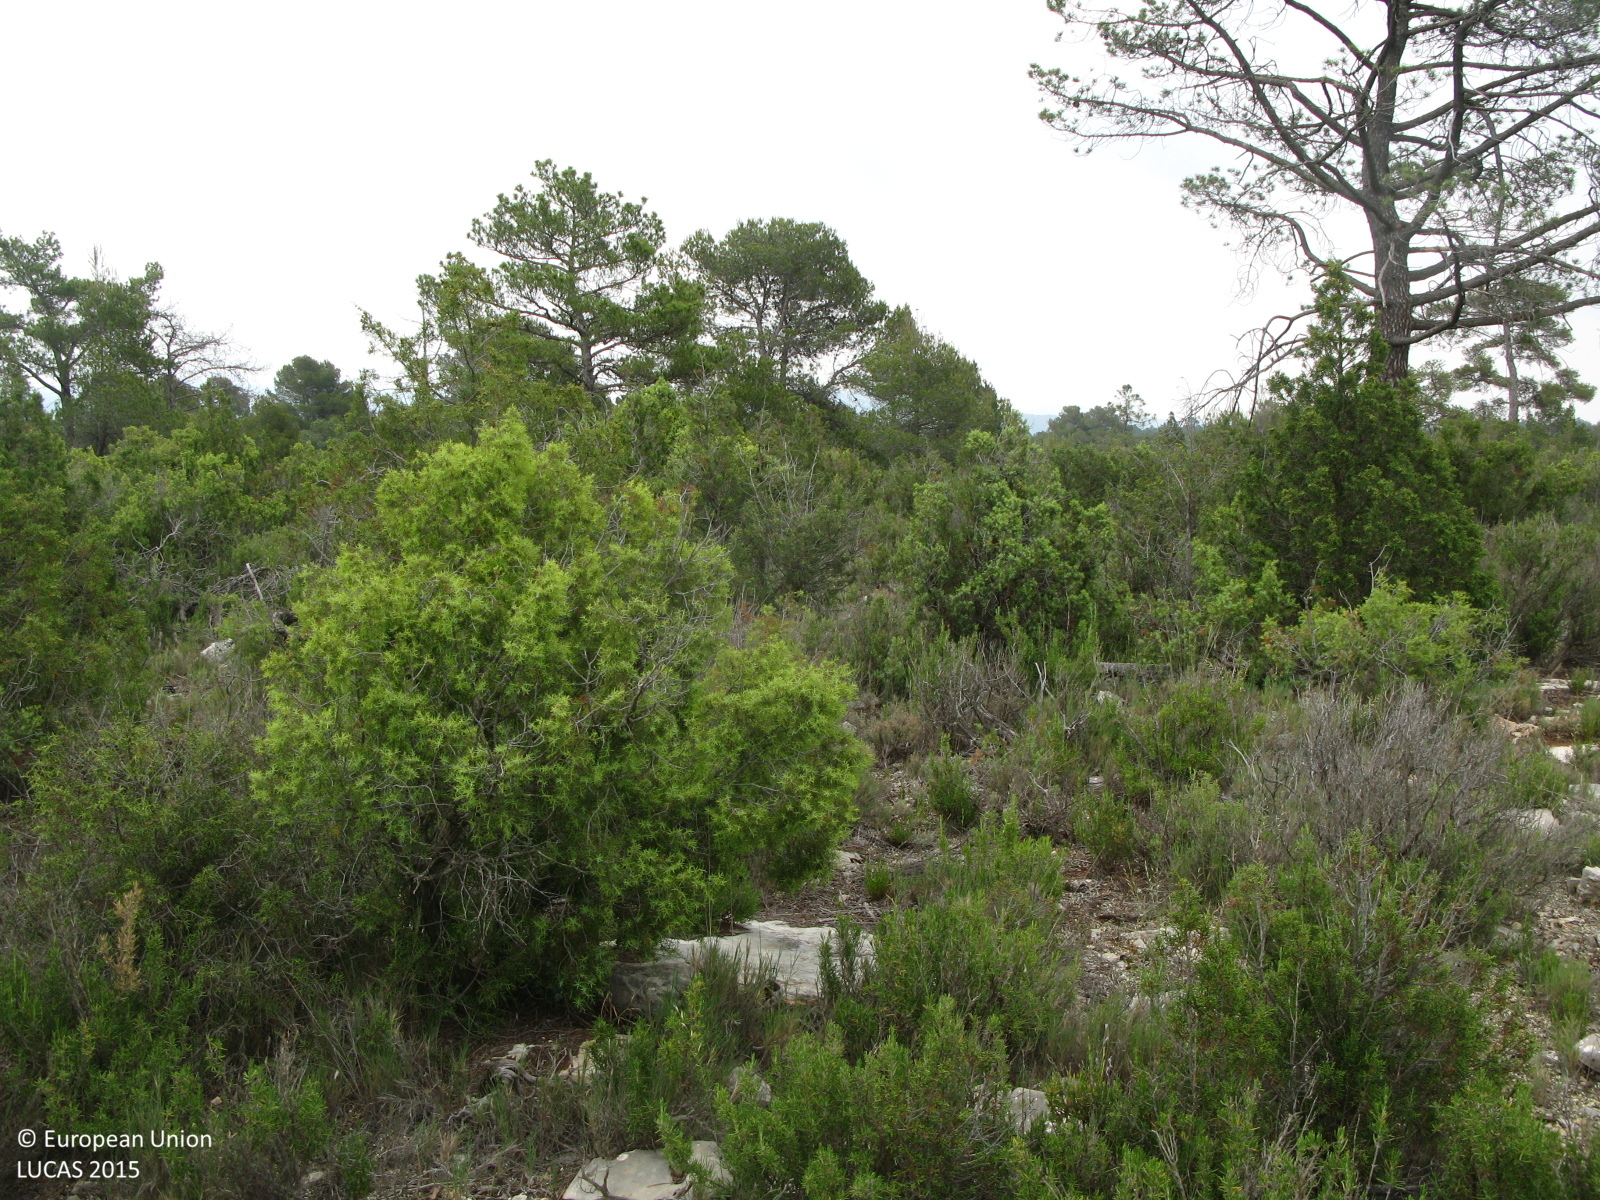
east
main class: Woodland
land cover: Pine dominated coniferous woodland
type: coniferous forest of the mediterranean region
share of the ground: 10 - 25 %
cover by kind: consolidated bare surface 40 %, shrubs 20 %, lichens and mosses 20 %, coniferous forest trees 15 %, herbaceous plants 5 %
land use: Forestry
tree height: > 5 m
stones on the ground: > 50 %
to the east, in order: Pine dominated coniferous woodland; Shrubland with sparse tree cover; Pine dominated coniferous woodland; Shrubland with sparse tree cover; Shrubland without tree cover; Tracks; Shrubland with sparse tree cover; Pine dominated coniferous woodland
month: June
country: ES
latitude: 39.9209
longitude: -1.1563
